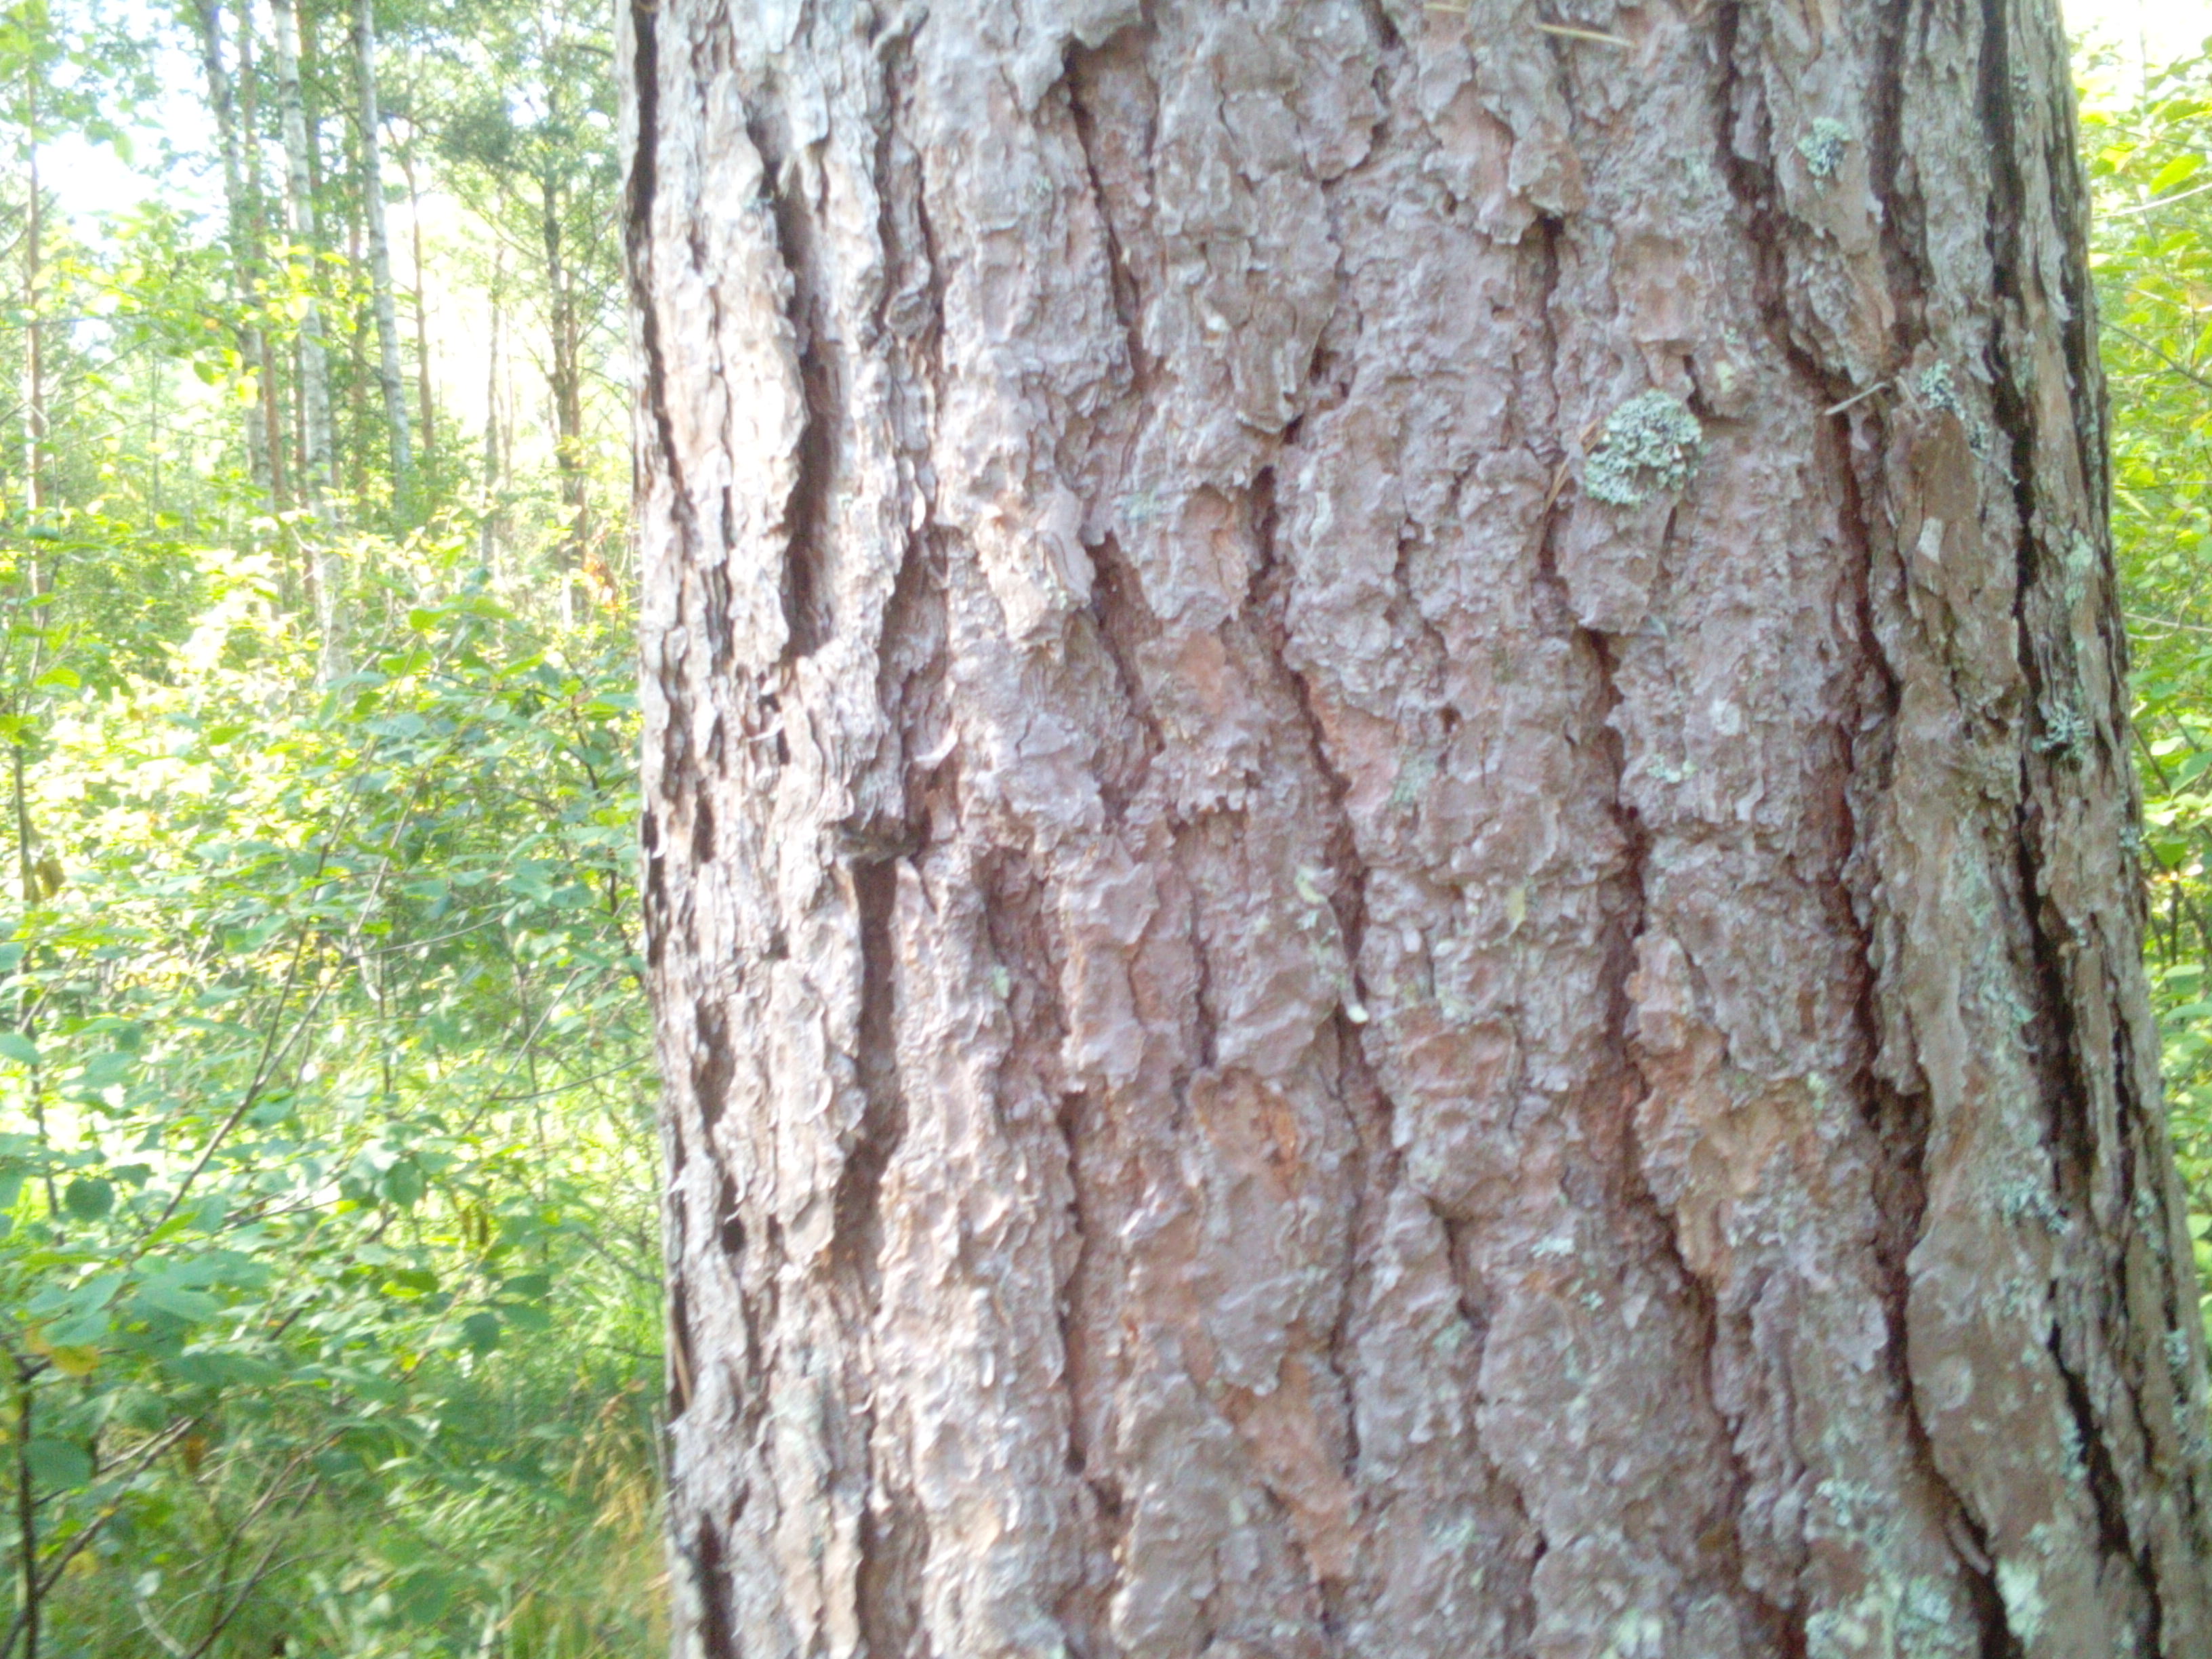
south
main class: Woodland
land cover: Pine dominated mixed woodland
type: hemiboreal forest and nemoral coniferous forest and mixed broadleaved-coniferous forest
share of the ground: > 75 %
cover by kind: coniferous forest trees 50 %, broadleaved forest trees 35 %, herbaceous plants 10 %, shrubs 5 %
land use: Forestry
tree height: > 5 m
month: August
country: LV
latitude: 56.7371
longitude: 21.1365
